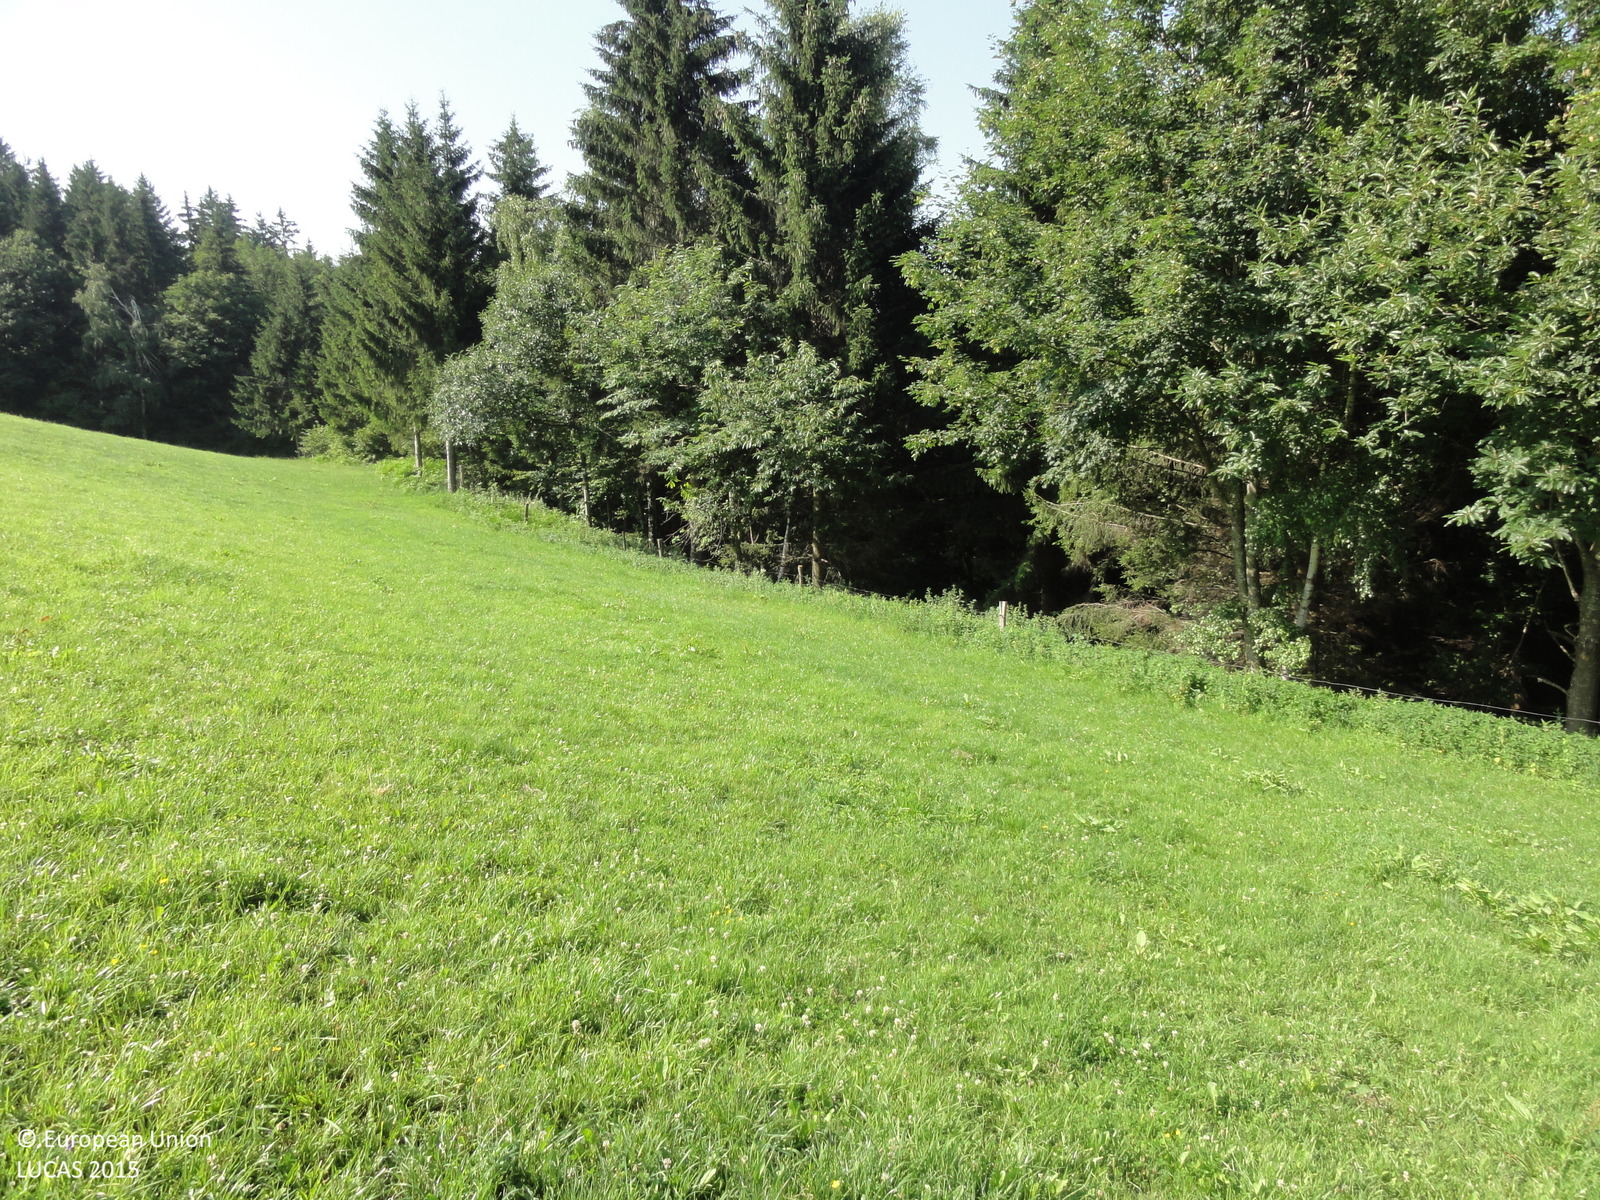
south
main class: Grassland
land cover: Grassland without tree/shrub cover
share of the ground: > 75 %
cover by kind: herbaceous plants 100 %
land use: Agriculture (excluding fallow land and kitchen gardens)
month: July
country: SI
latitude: 46.4608
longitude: 15.5325
